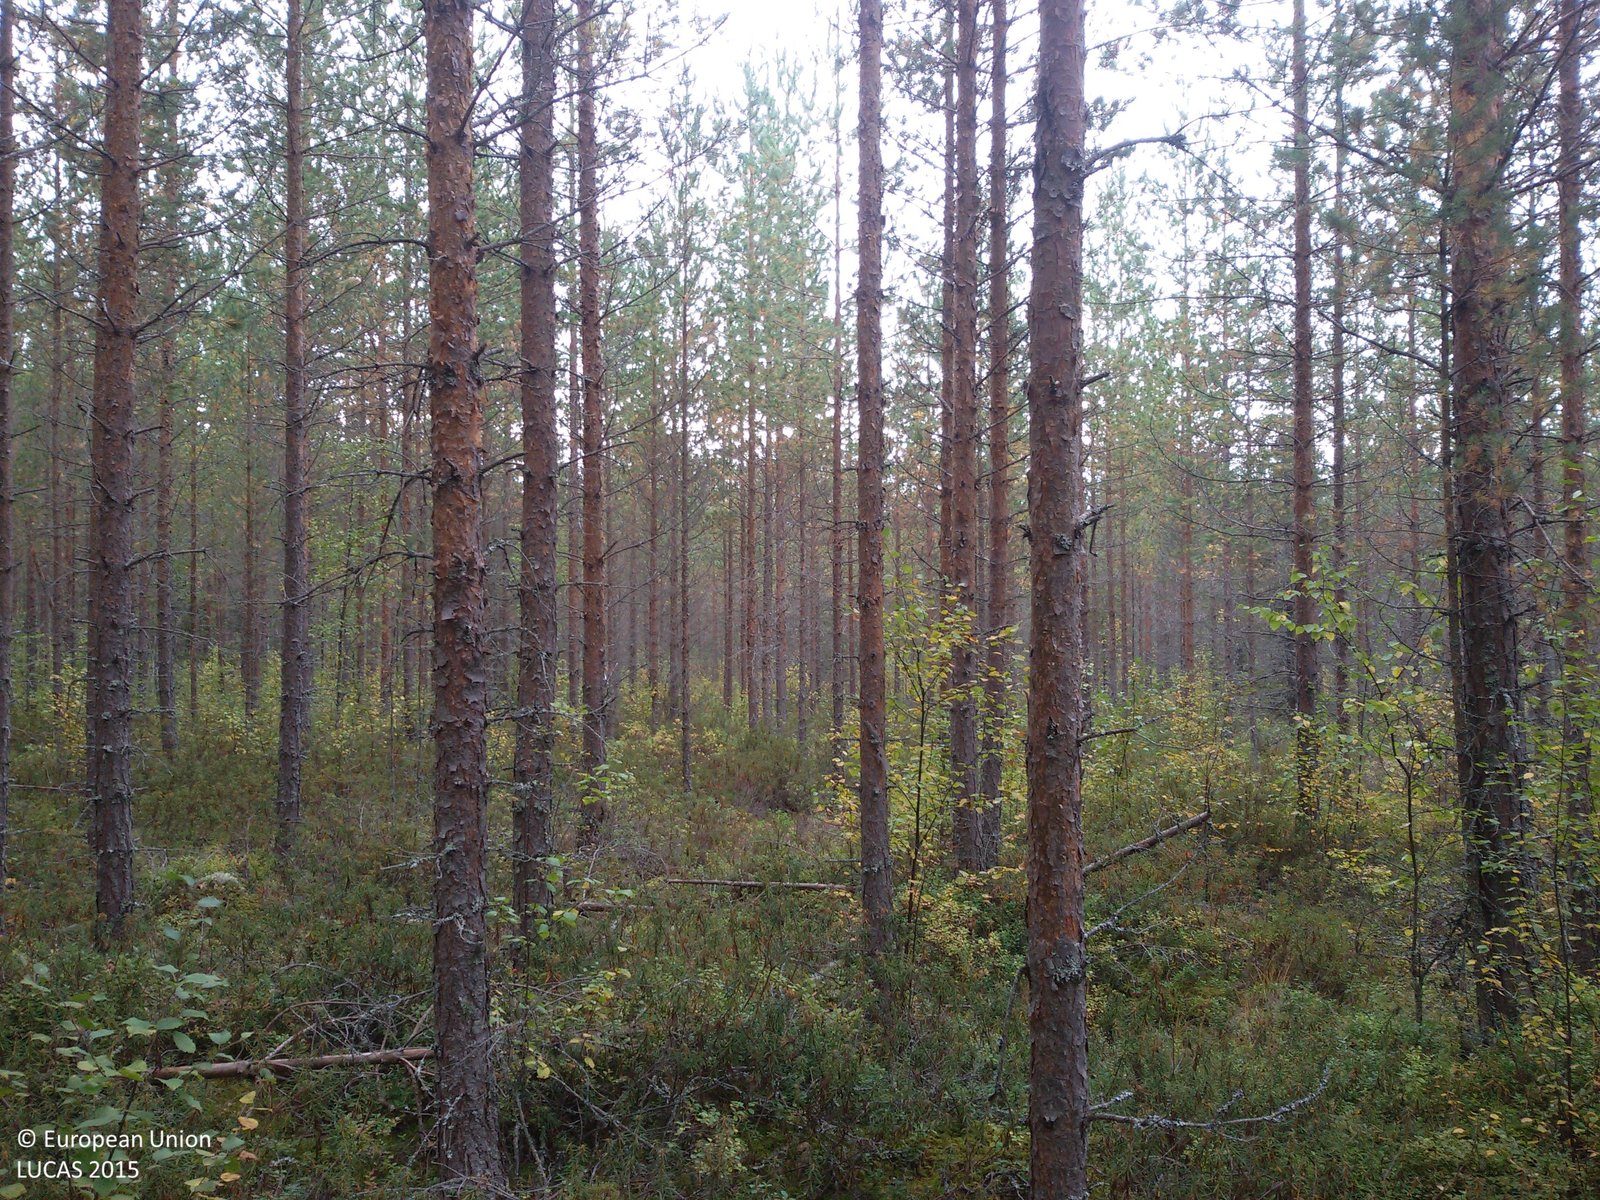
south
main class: Woodland
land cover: Pine dominated coniferous woodland
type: boreal forest
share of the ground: > 75 %
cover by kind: coniferous forest trees 75 %, shrubs 15 %, lichens and mosses 10 %
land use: Forestry
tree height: > 5 m
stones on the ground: 10 - 25 %
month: September
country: SE
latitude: 60.8020
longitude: 14.8200
